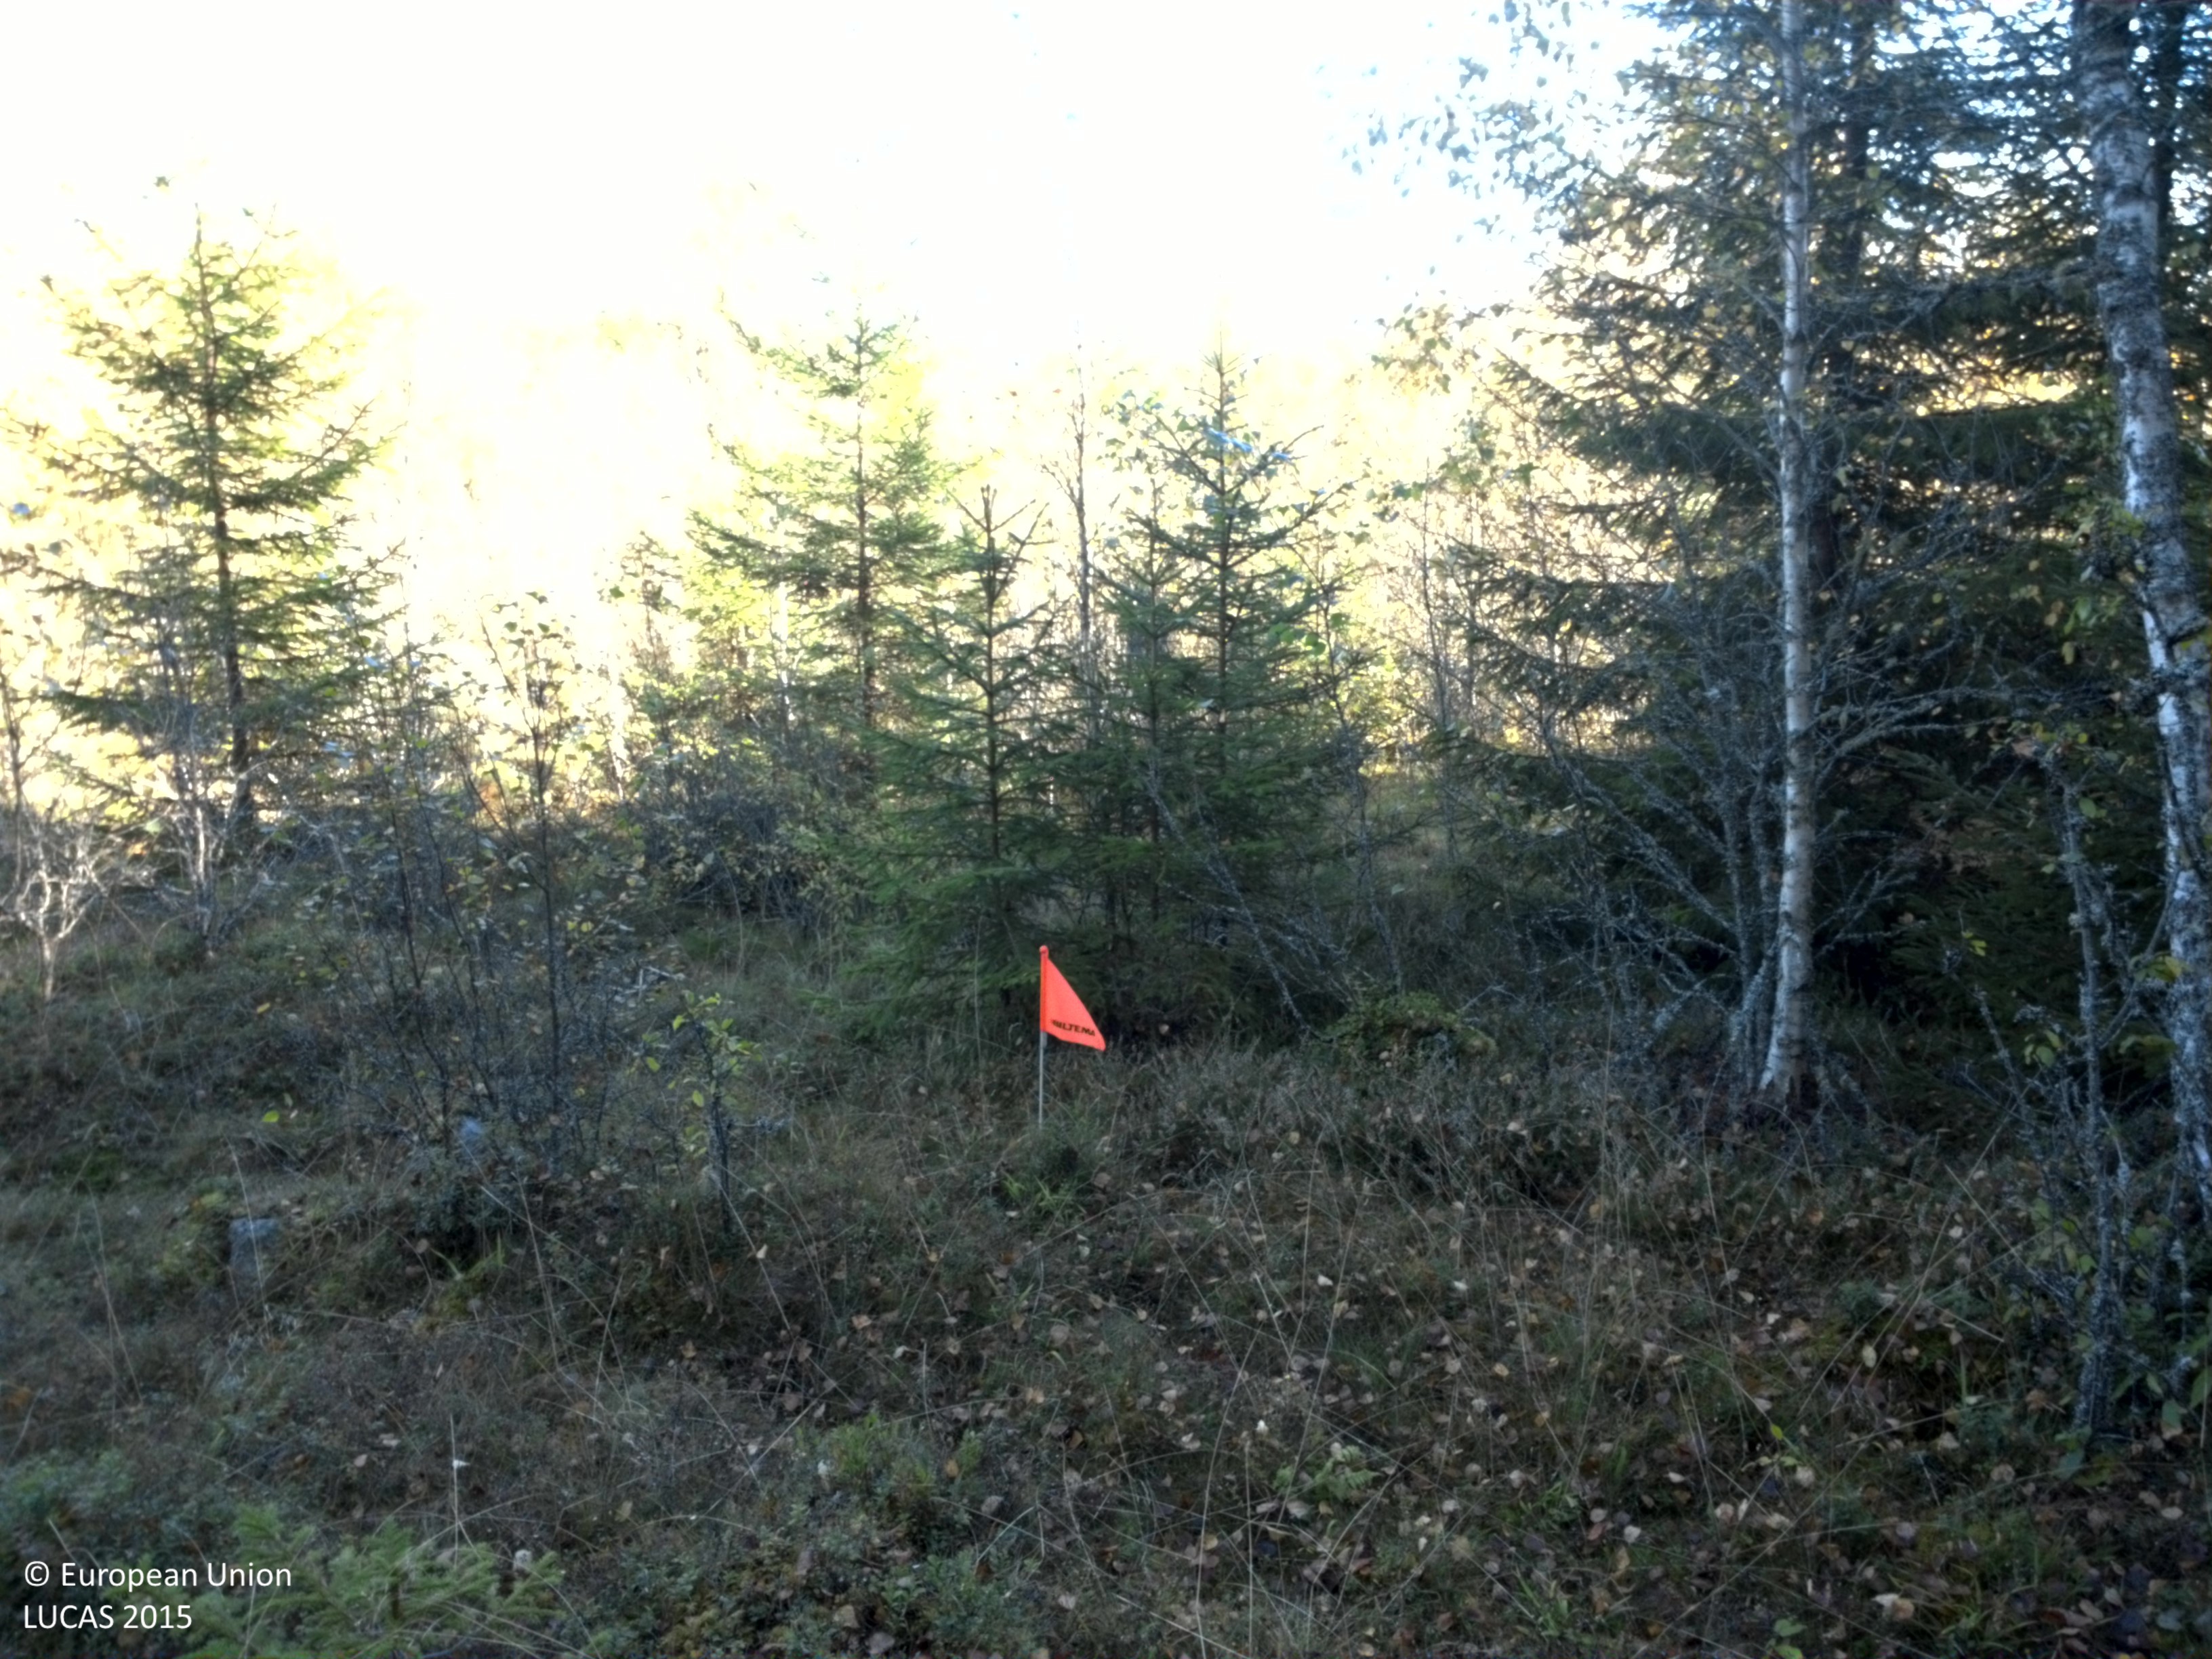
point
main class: Woodland
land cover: Spruce dominated mixed woodland
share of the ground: 10 - 25 %
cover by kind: shrubs 30 %, herbaceous plants 30 %, coniferous forest trees 15 %, lichens and mosses 15 %, broadleaved forest trees 10 %
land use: Forestry
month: September
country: SE
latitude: 59.1309
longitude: 14.0635
